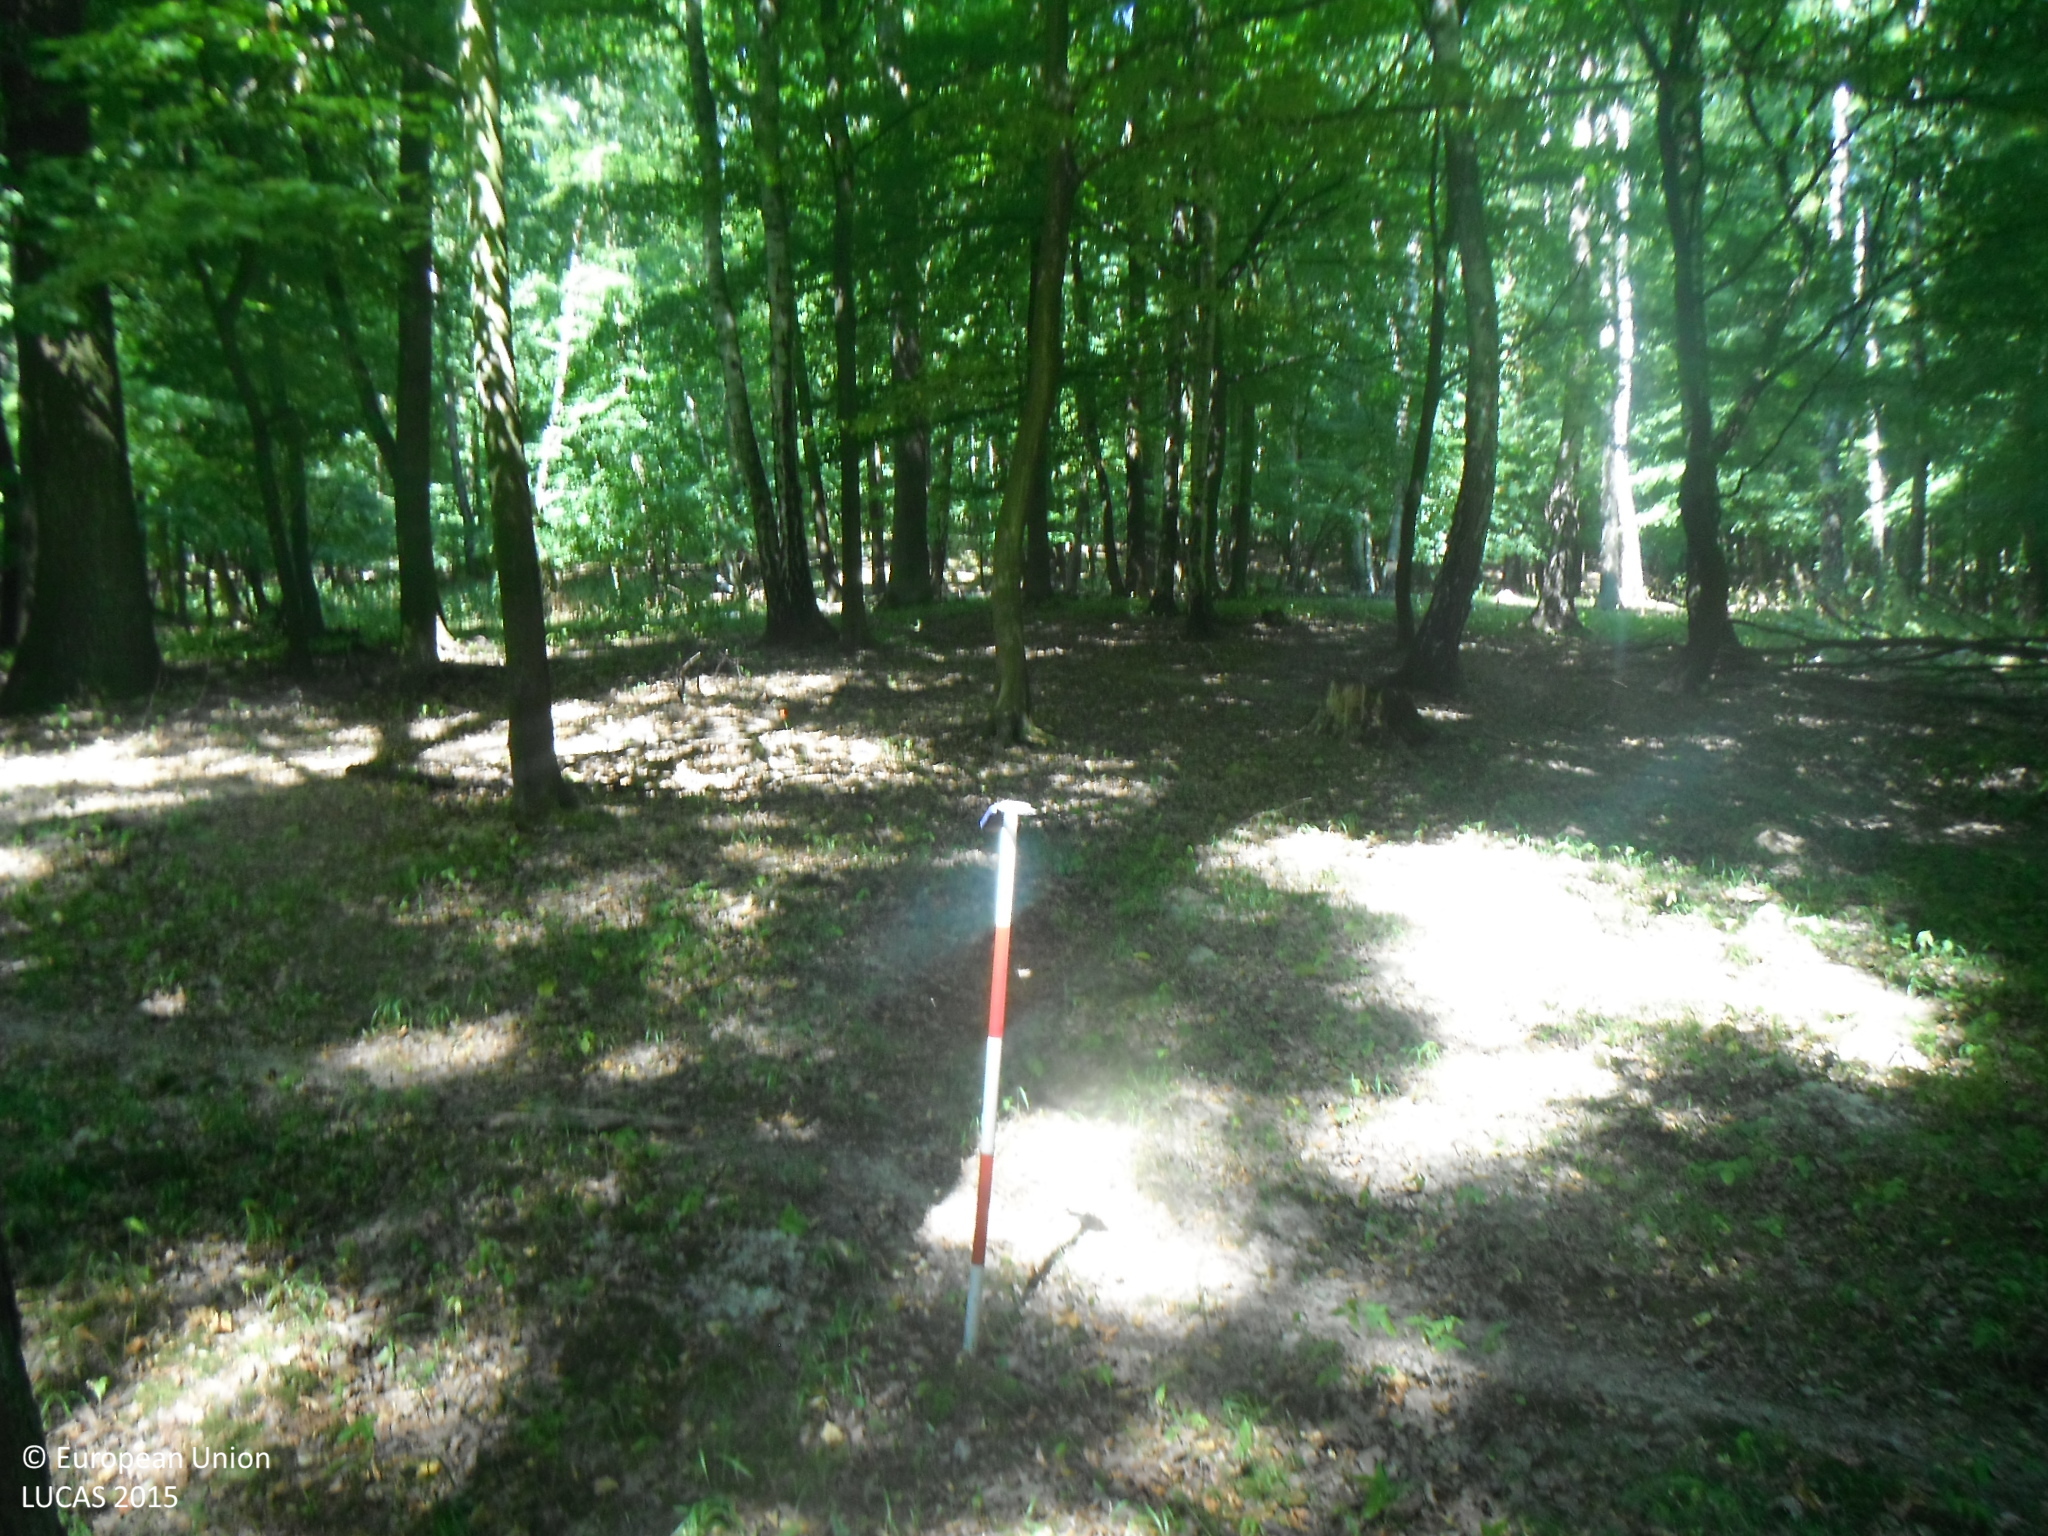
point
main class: Woodland
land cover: Broadleaved woodland
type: mesophytic deciduous forest
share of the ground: > 75 %
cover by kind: broadleaved forest trees 95 %, herbaceous plants 5 %
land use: Forestry
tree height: > 5 m
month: July
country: SK
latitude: 48.7250
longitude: 17.2554
